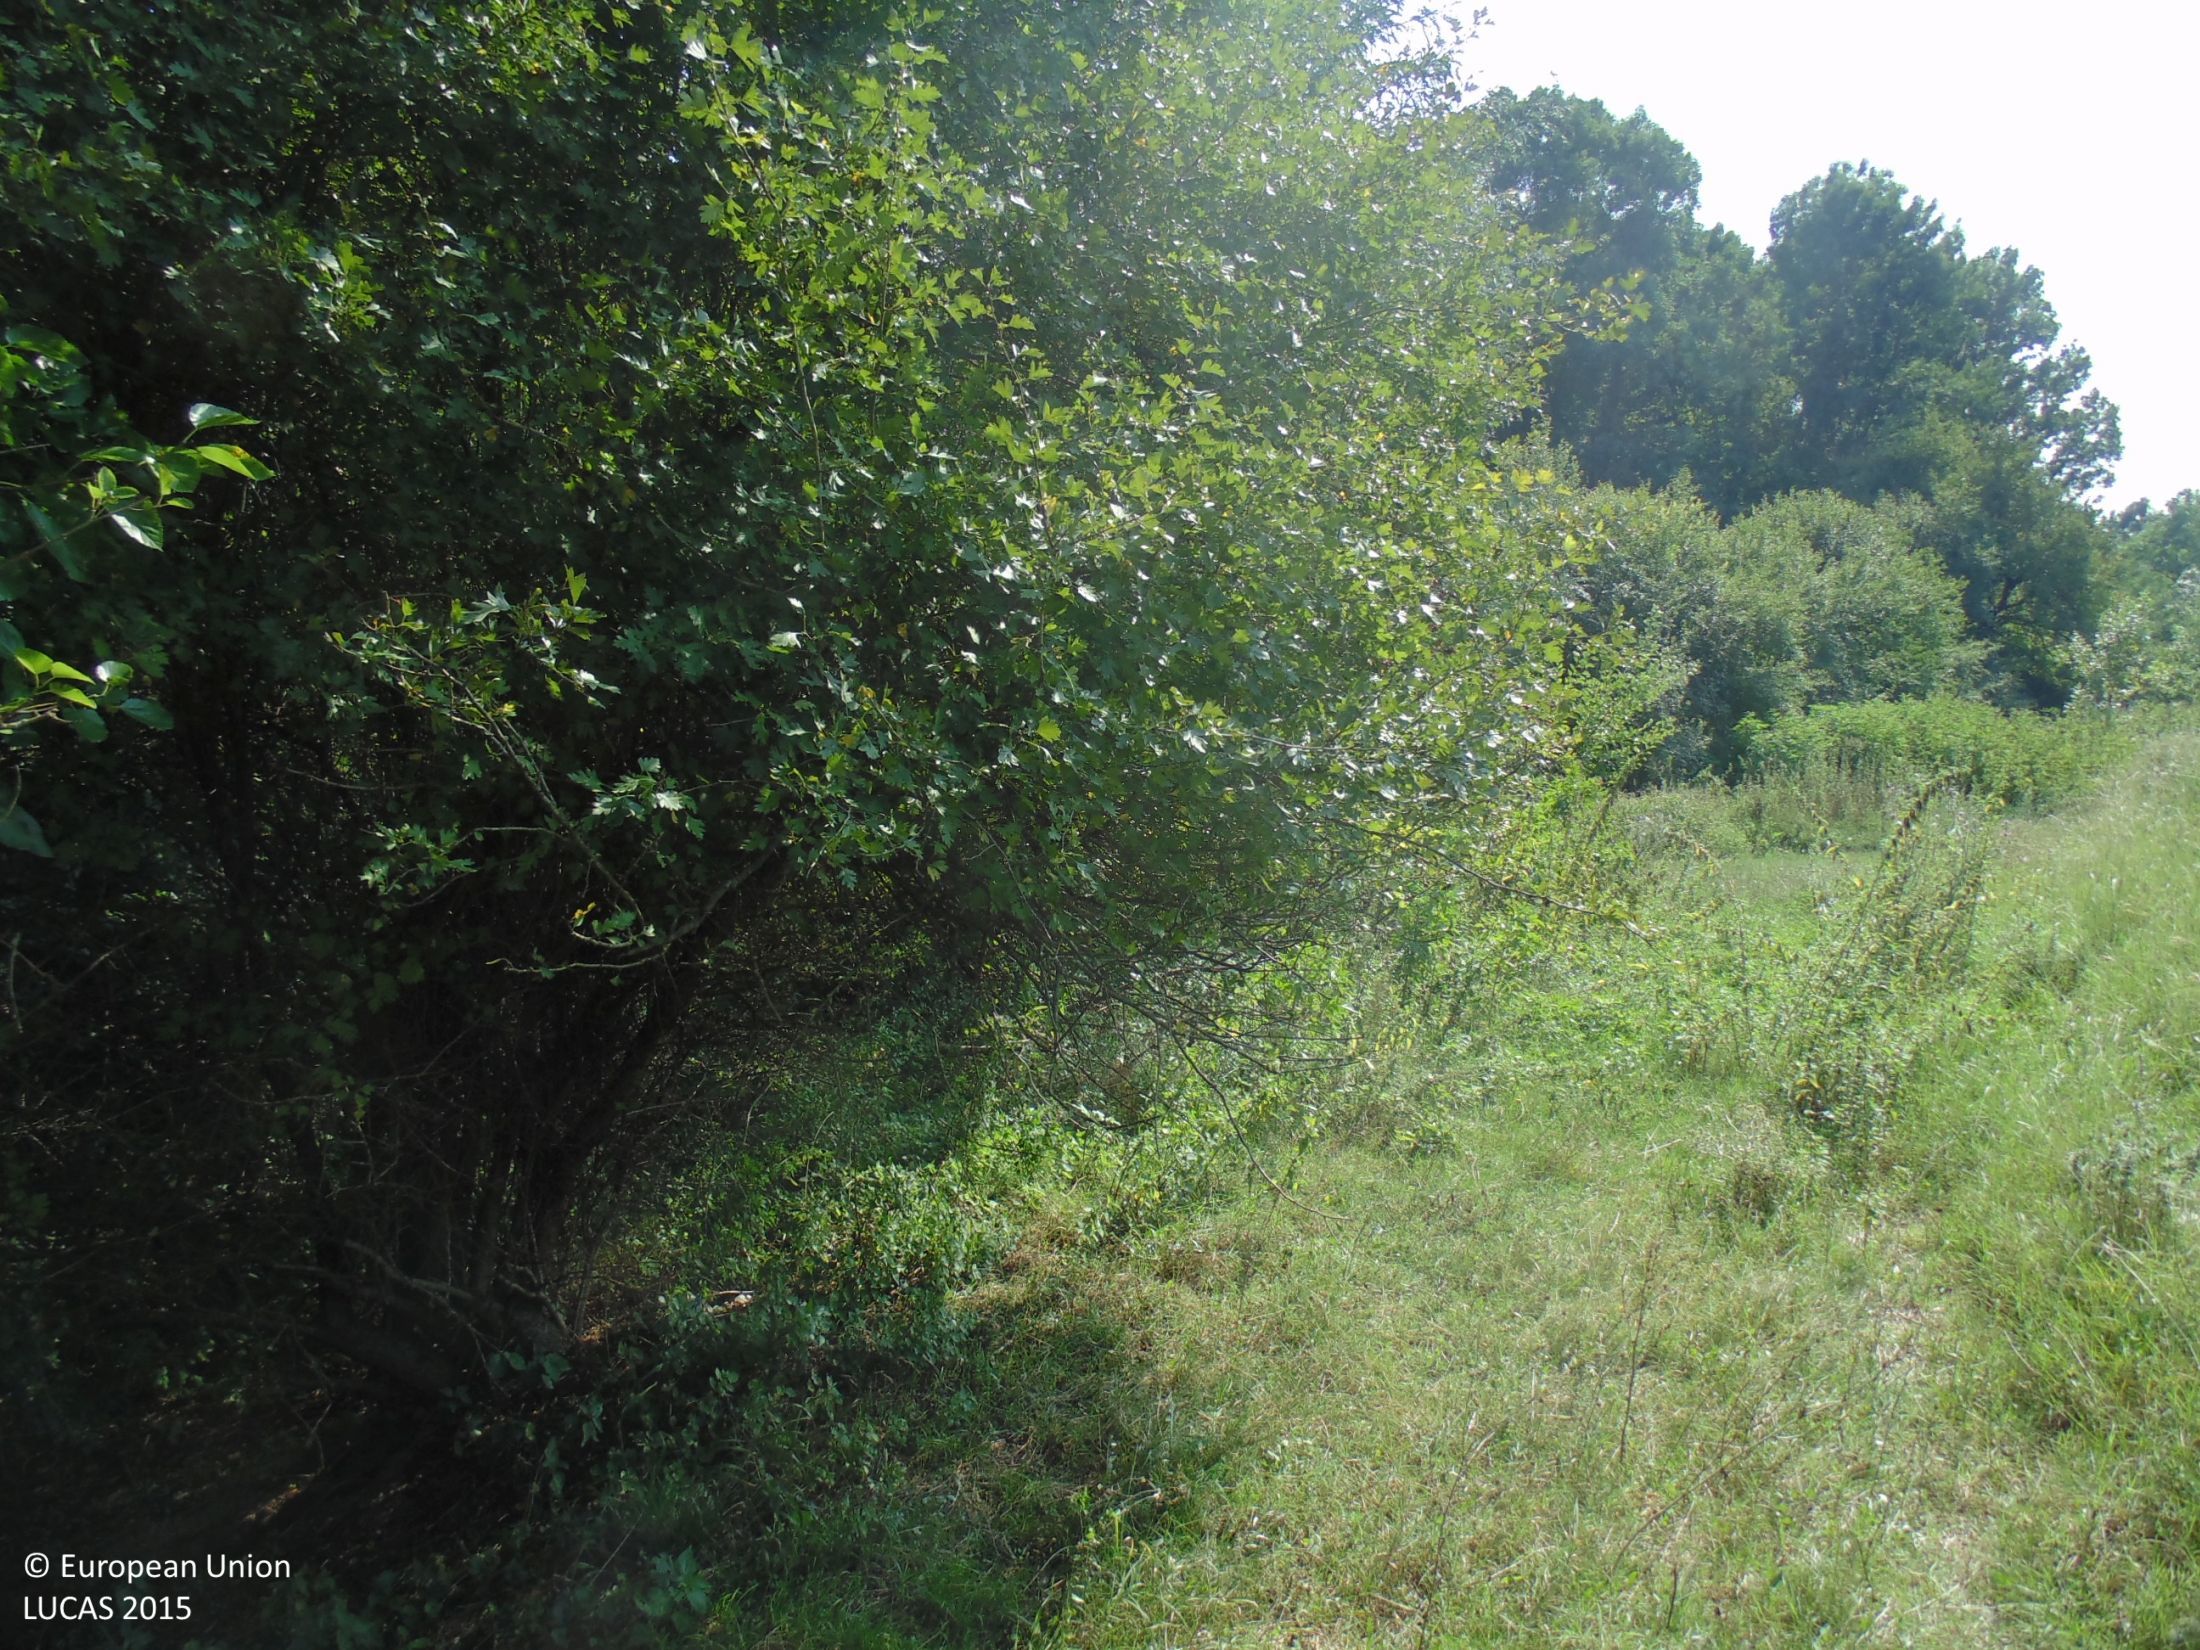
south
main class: Grassland
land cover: Grassland without tree/shrub cover
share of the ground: > 75 %
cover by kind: herbaceous plants 100 %
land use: Agriculture (excluding fallow land and kitchen gardens)
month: August
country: BG
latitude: 43.9496
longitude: 27.3141
